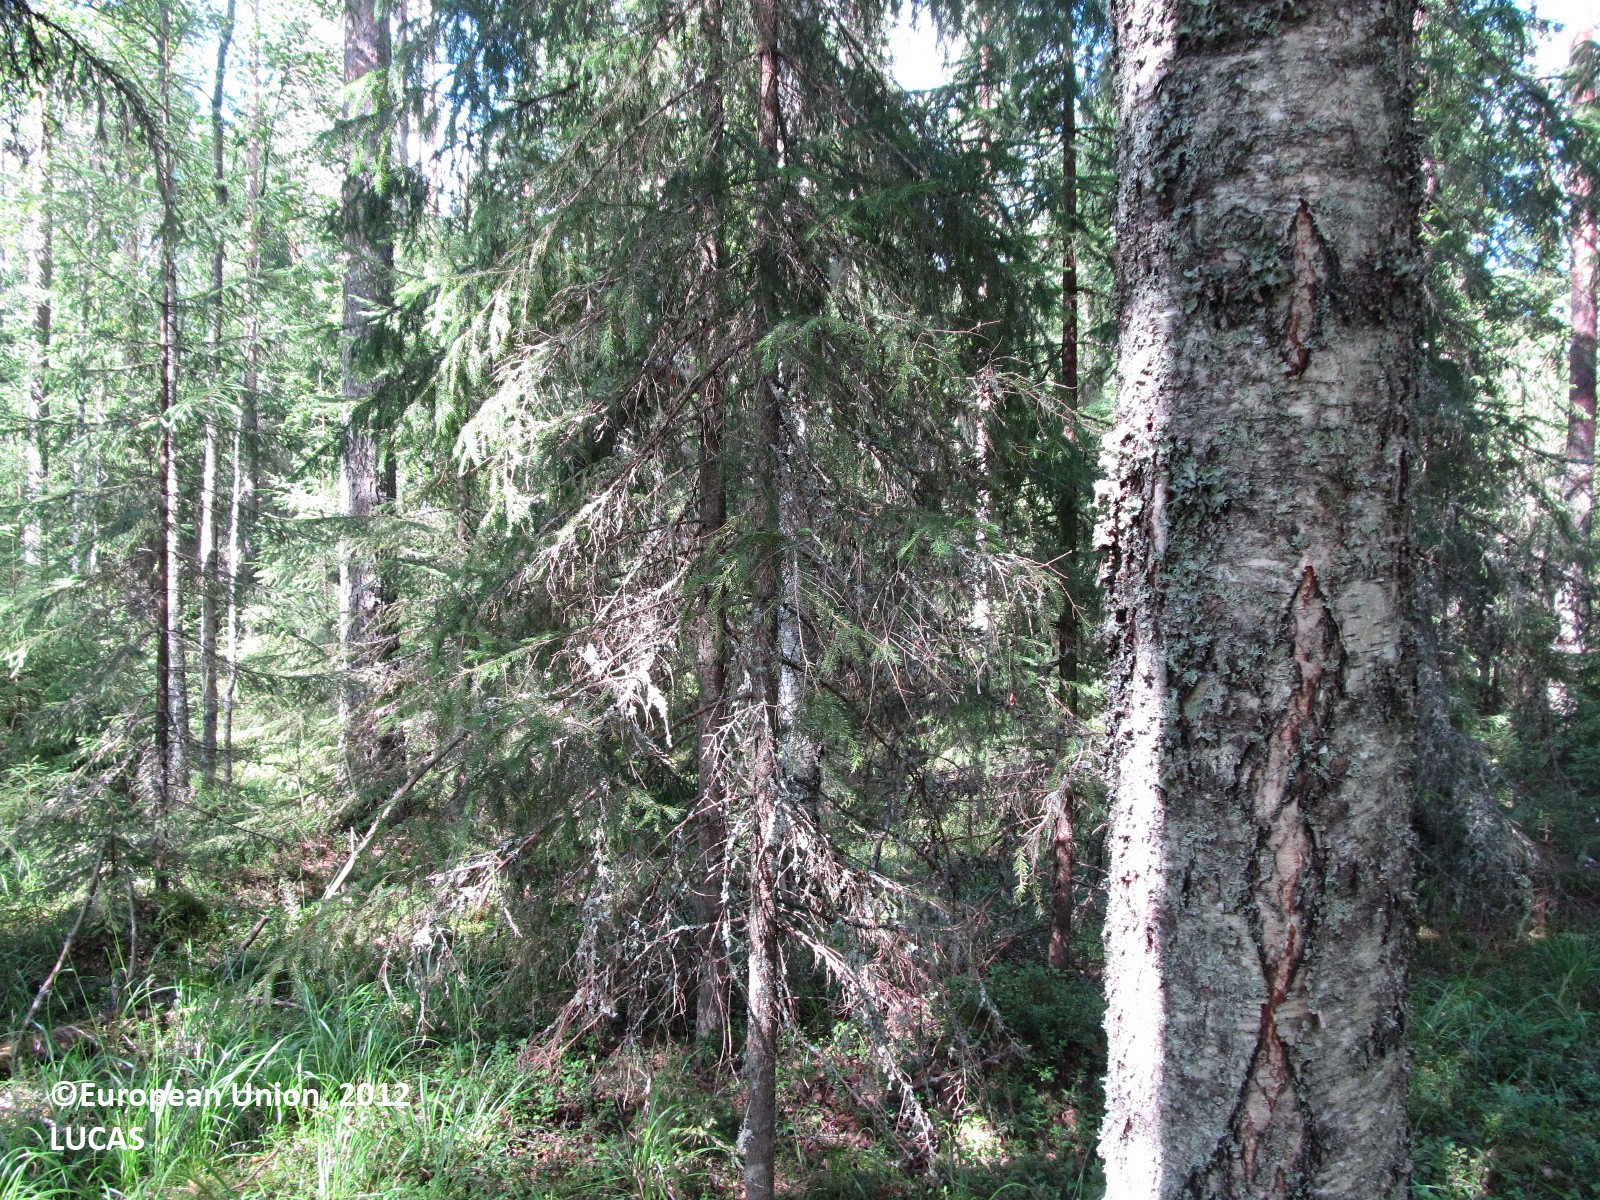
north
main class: Woodland
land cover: Spruce dominated coniferous woodland
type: boreal forest
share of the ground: 50 - 75 %
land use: Forestry
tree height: > 5 m
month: July
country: FI
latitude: 61.9482
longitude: 27.9336
